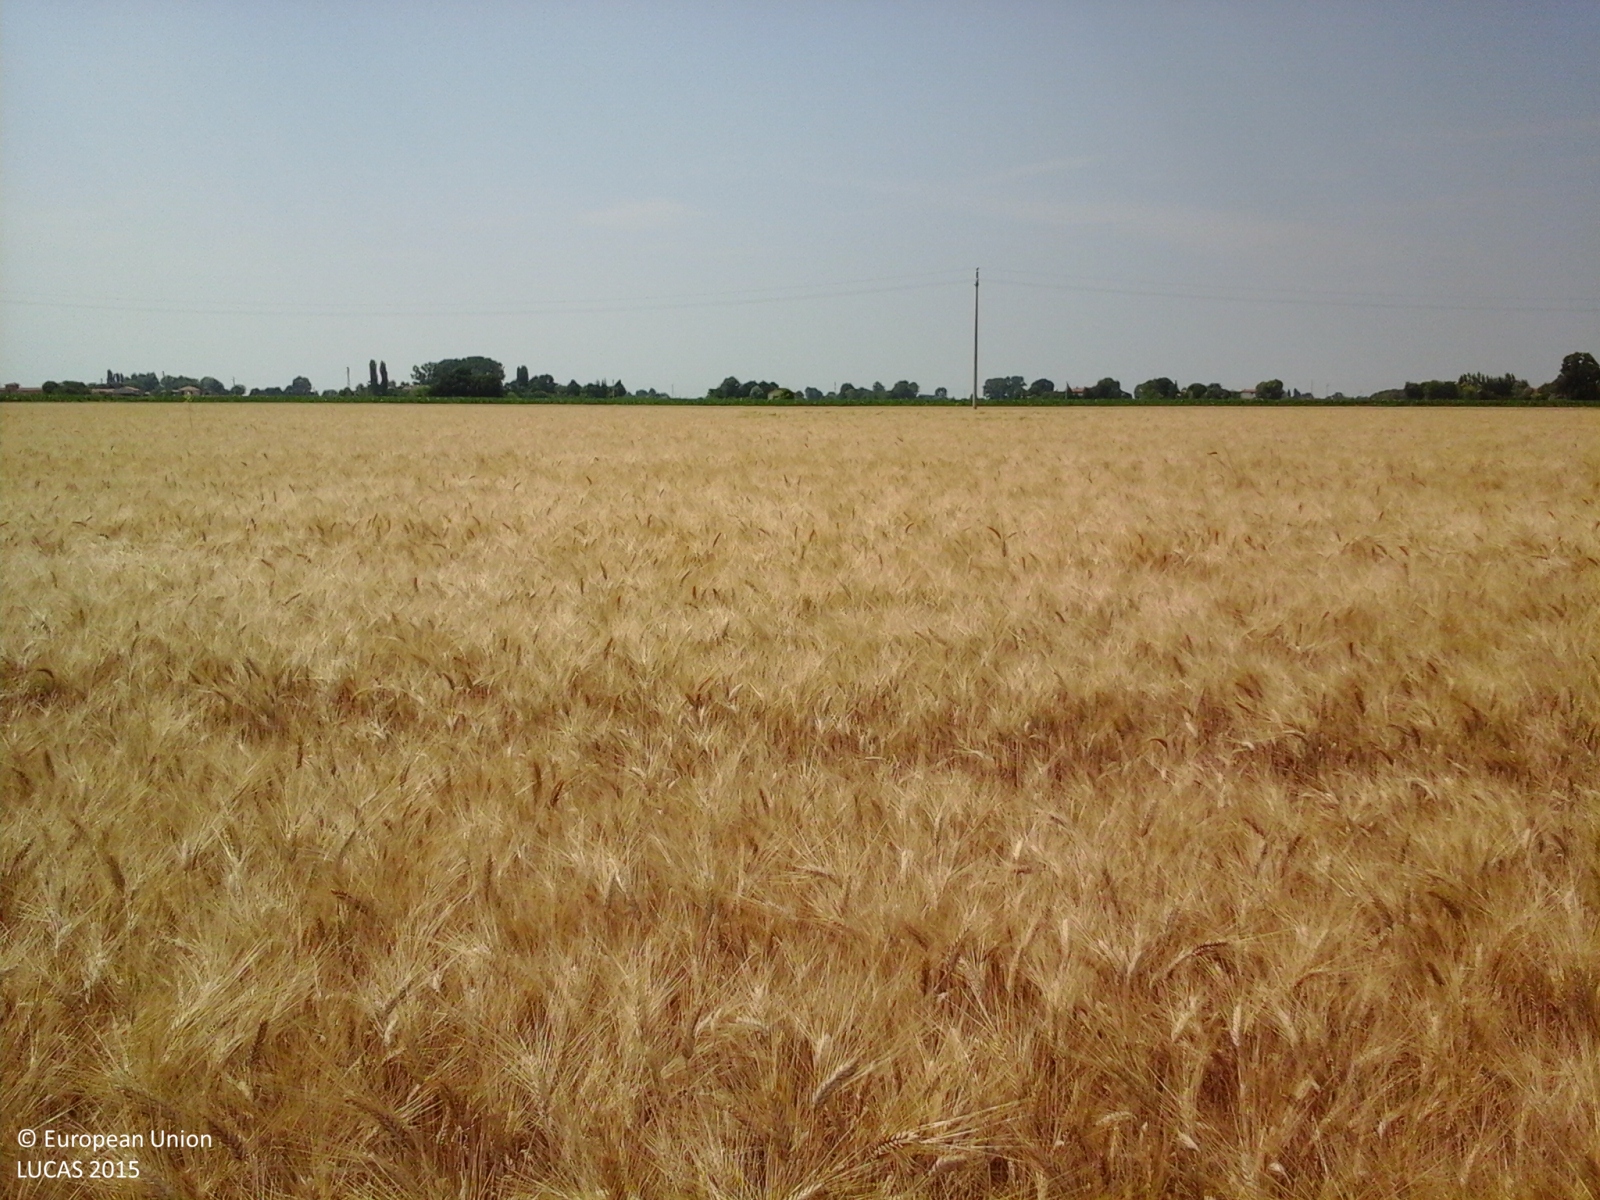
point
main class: Cropland
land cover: Common wheat
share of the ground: > 75 %
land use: Agriculture (excluding fallow land and kitchen gardens)
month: June
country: IT
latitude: 44.5908
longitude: 11.5964
